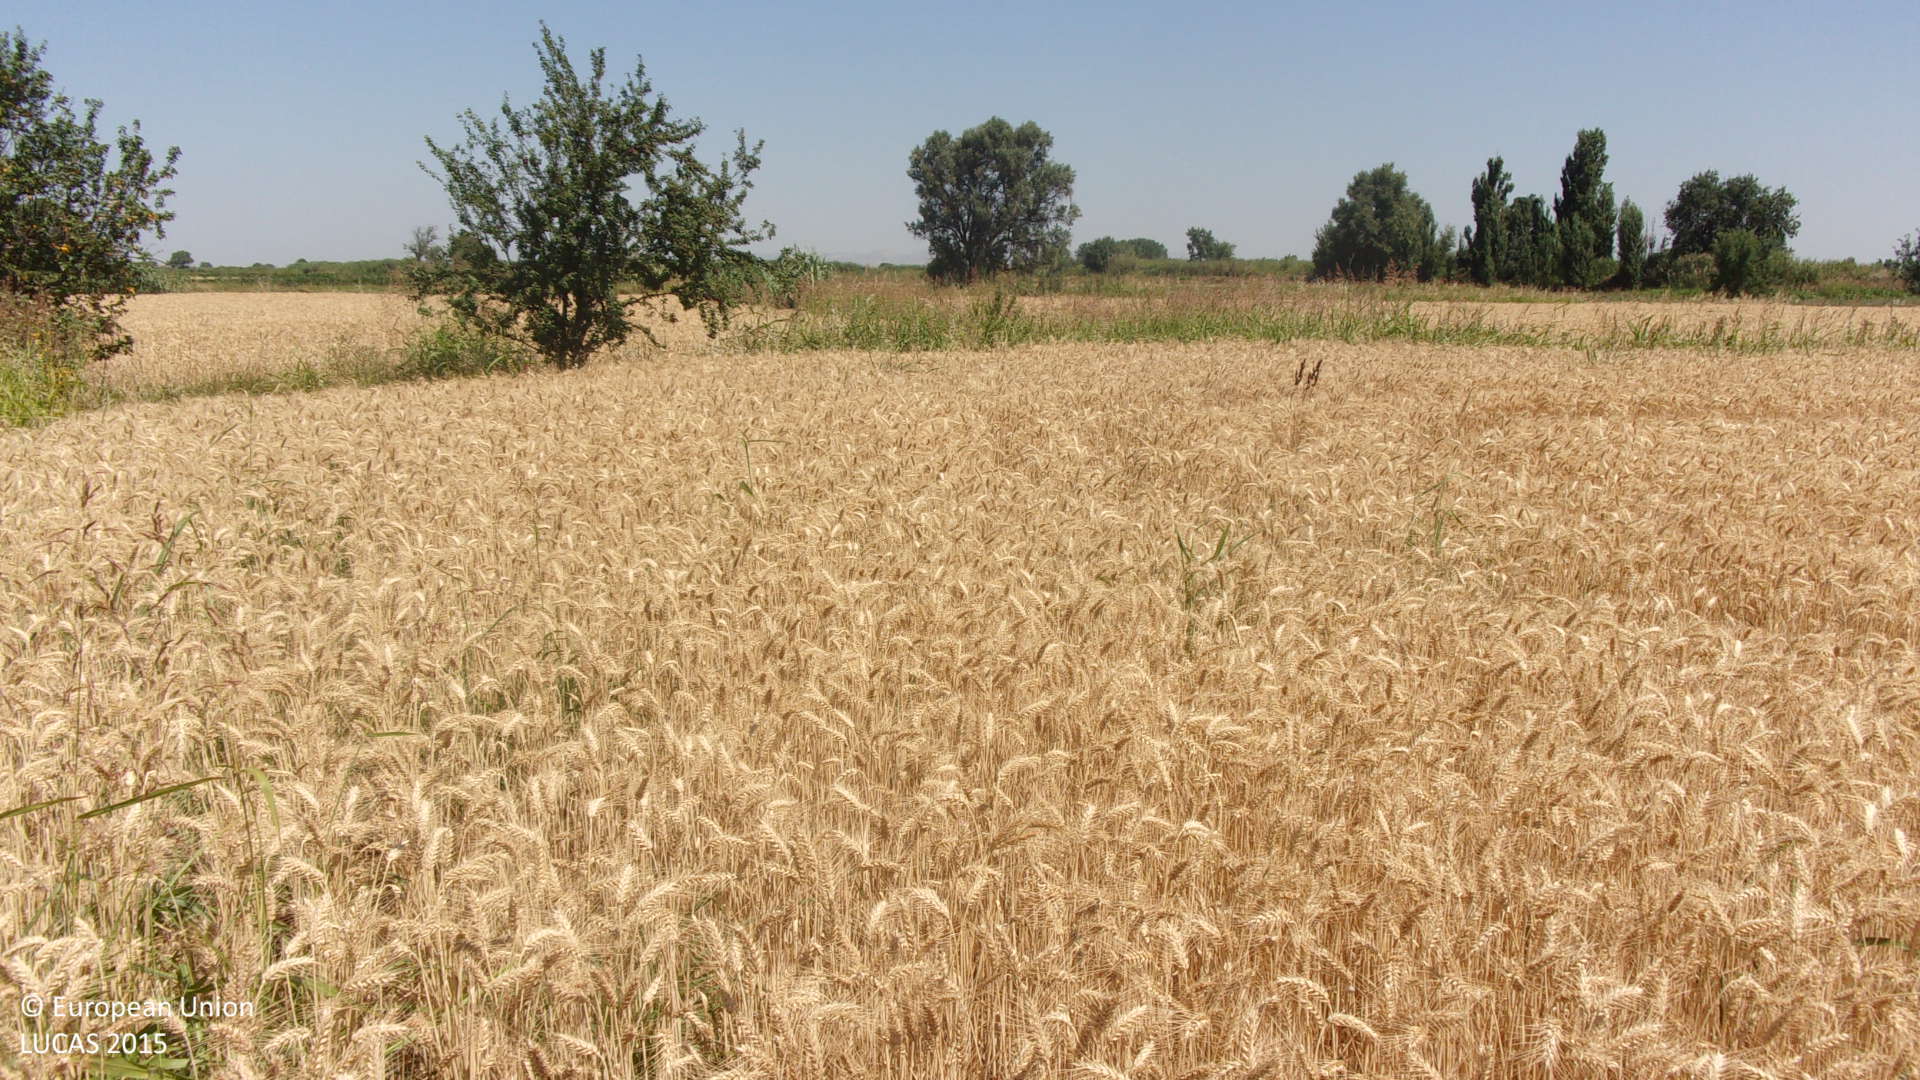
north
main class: Cropland
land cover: Common wheat
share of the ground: > 75 %
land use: Agriculture (excluding fallow land and kitchen gardens)
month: July
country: ES
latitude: 41.8389
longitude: -1.2865
